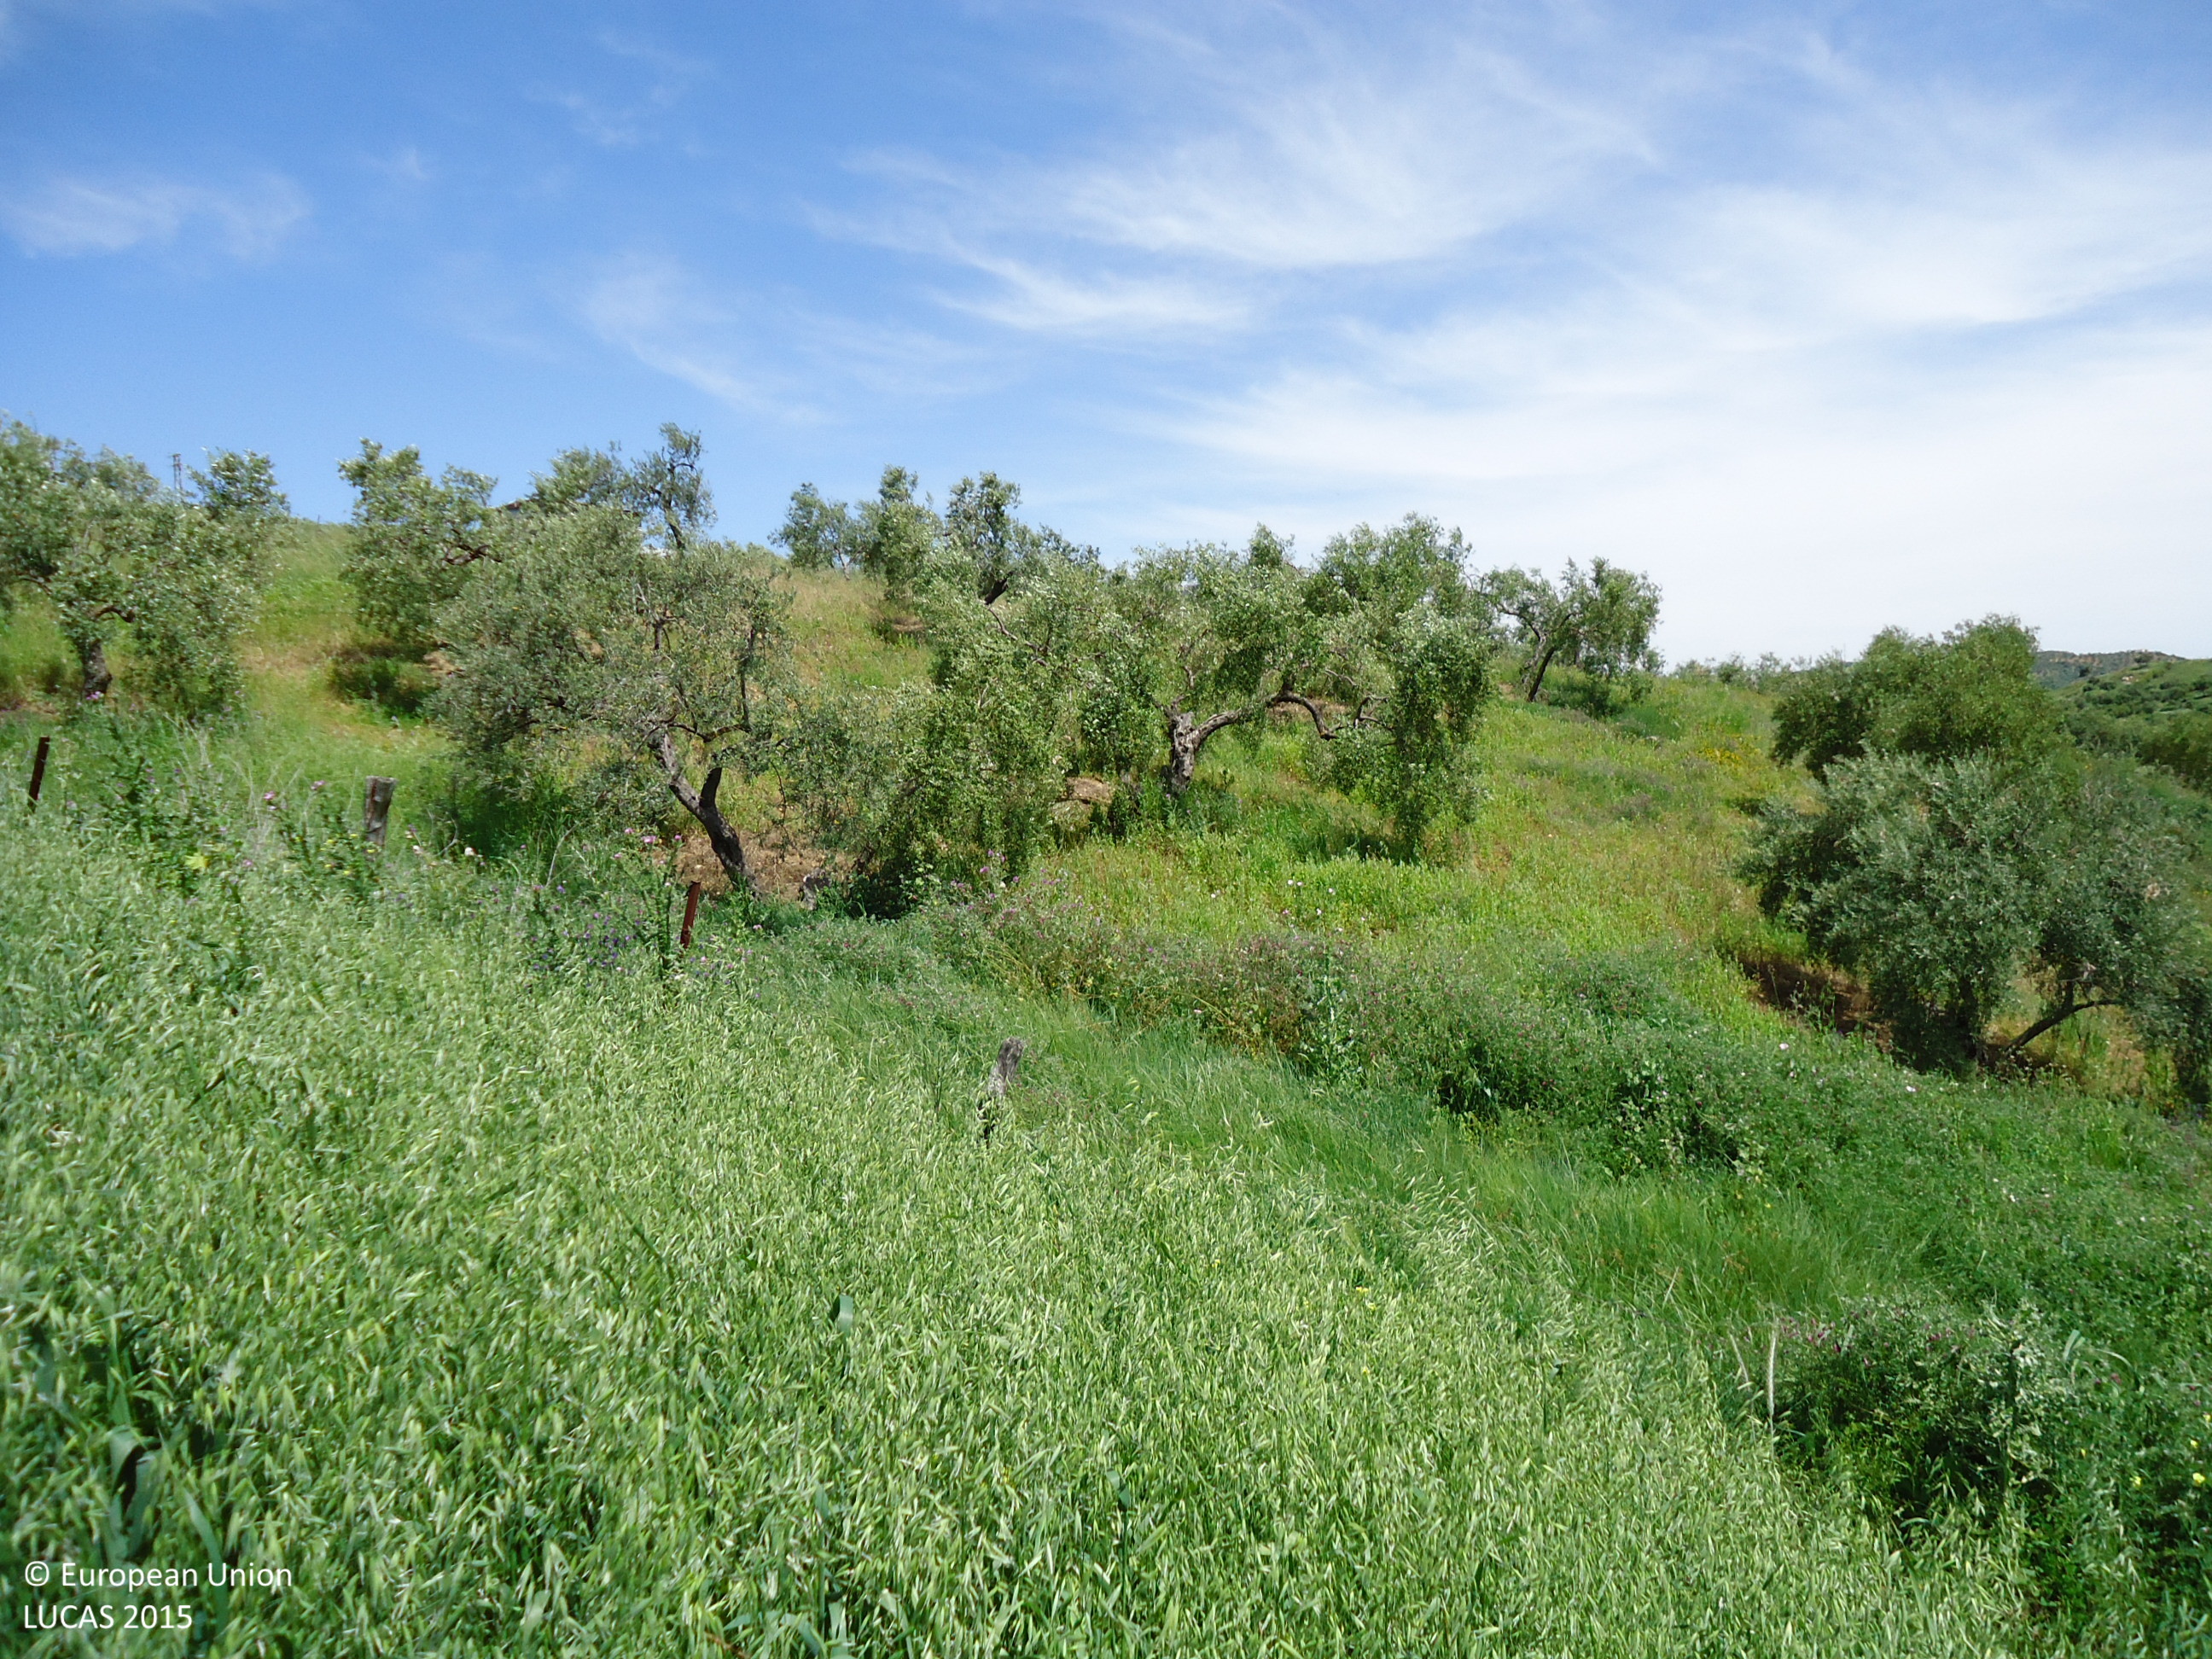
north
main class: Cropland
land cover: Oats
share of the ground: > 75 %
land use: Agriculture (excluding fallow land and kitchen gardens)
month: April
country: ES
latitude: 36.8492
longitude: -5.4253
